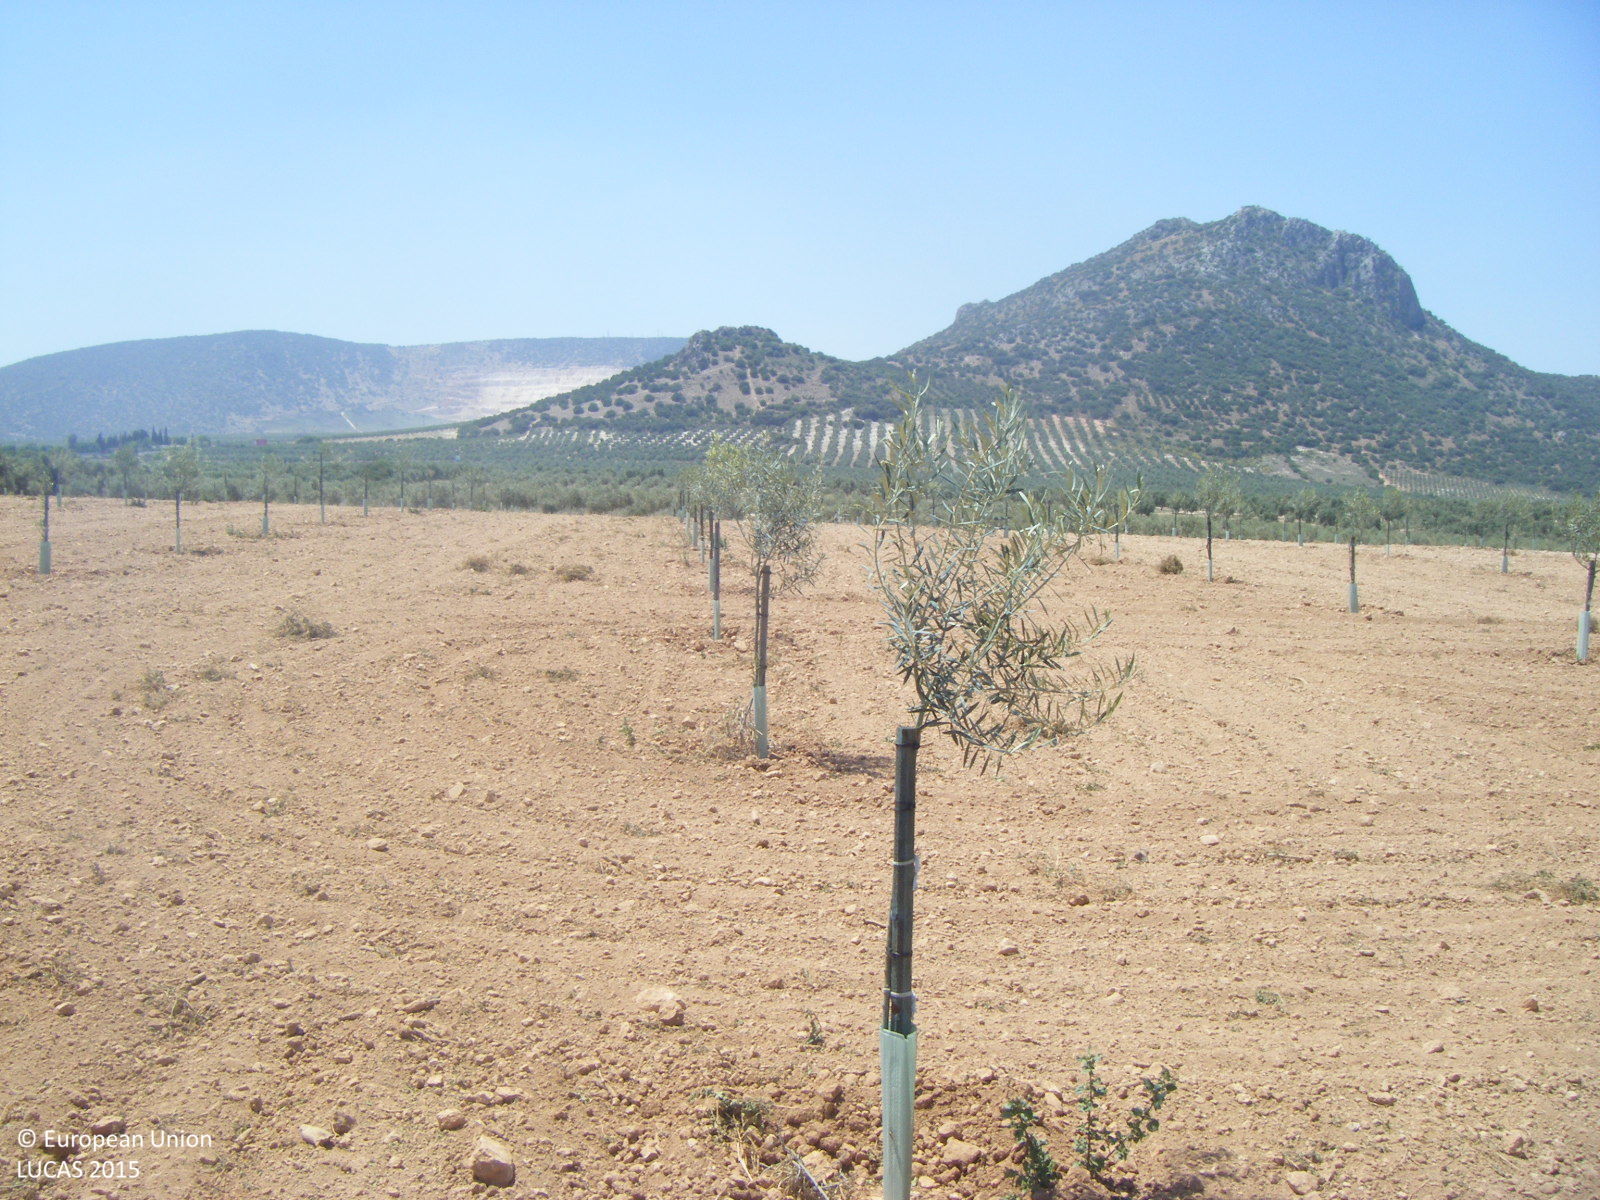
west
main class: Cropland
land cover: Olive groves
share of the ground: < 10 %
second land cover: Other bare soil
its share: > 75 %
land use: Agriculture (excluding fallow land and kitchen gardens)
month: May
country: ES
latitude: 37.2796
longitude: -4.8130
